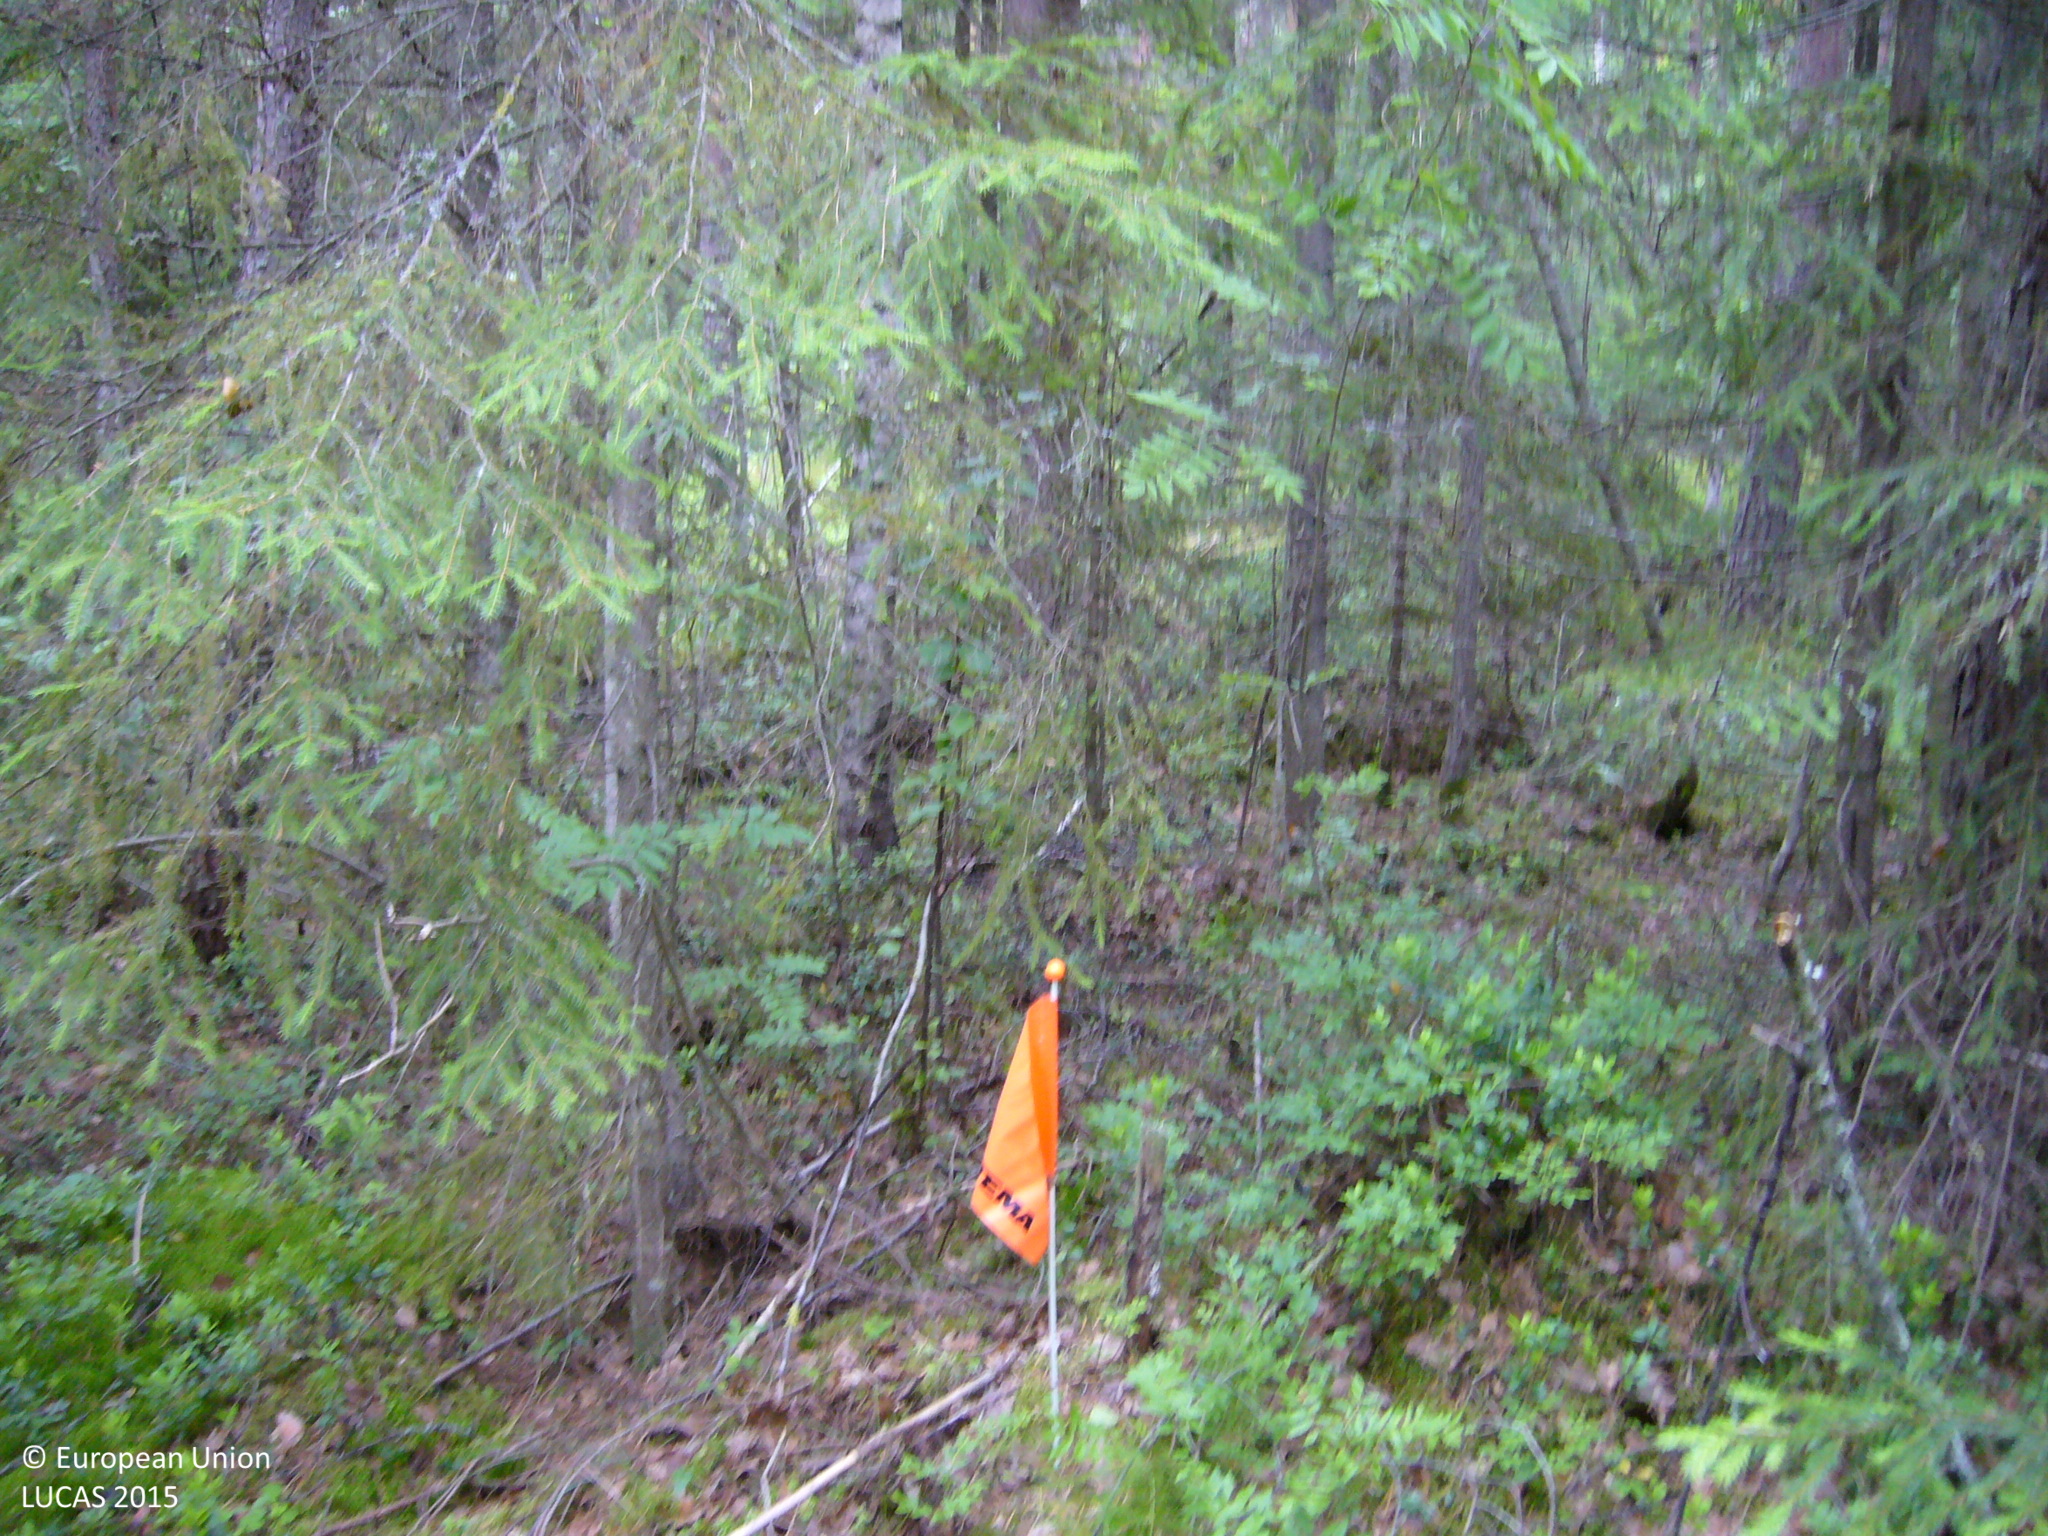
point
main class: Woodland
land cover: Spruce dominated mixed woodland
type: boreal forest
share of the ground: 50 - 75 %
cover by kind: coniferous forest trees 50 %, broadleaved forest trees 25 %, shrubs 25 %
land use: Forestry
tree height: > 5 m
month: July
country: FI
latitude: 63.2764
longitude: 25.8794
